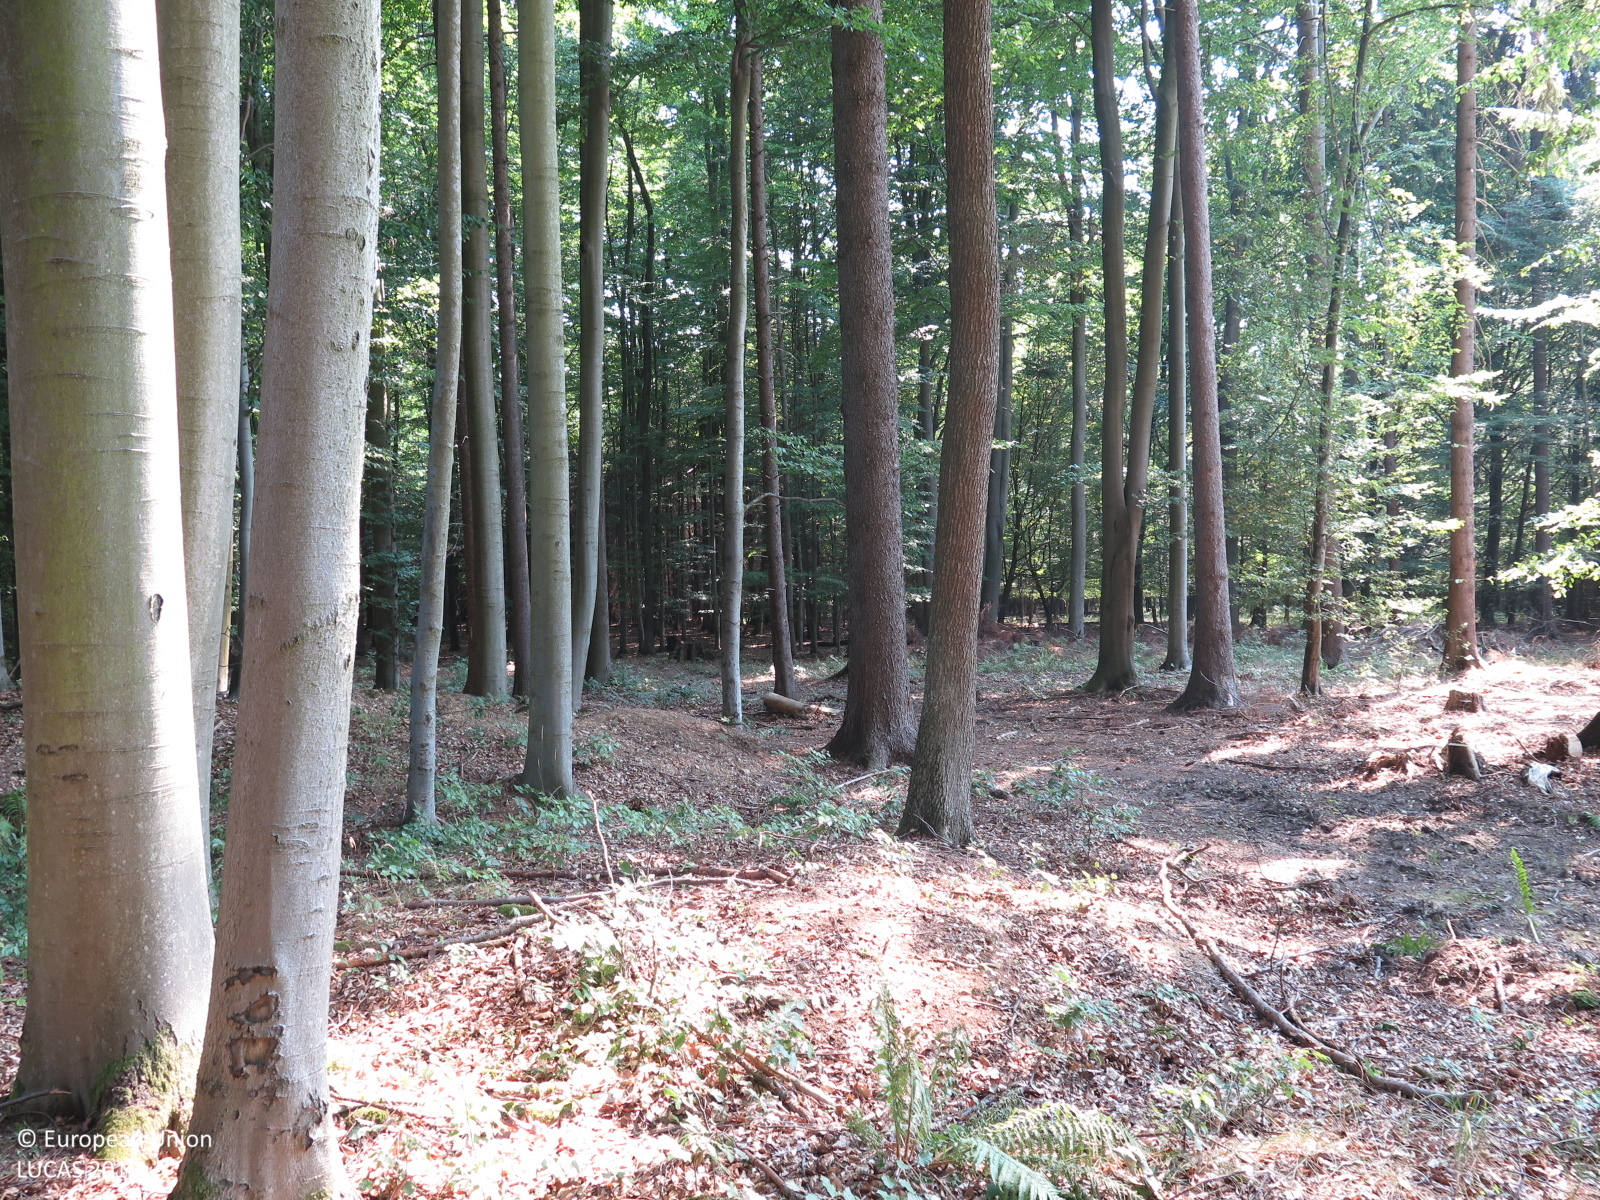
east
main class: Woodland
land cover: Spruce dominated mixed woodland
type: hemiboreal forest and nemoral coniferous forest and mixed broadleaved-coniferous forest
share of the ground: > 75 %
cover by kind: coniferous forest trees 65 %, broadleaved forest trees 30 %, herbaceous plants 5 %
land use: Forestry
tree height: > 5 m
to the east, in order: Spruce dominated mixed woodland; Broadleaved woodland; Spruce dominated coniferous woodland; Tracks; Spruce dominated coniferous woodland
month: August
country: CZ
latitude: 49.9219
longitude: 13.8310
